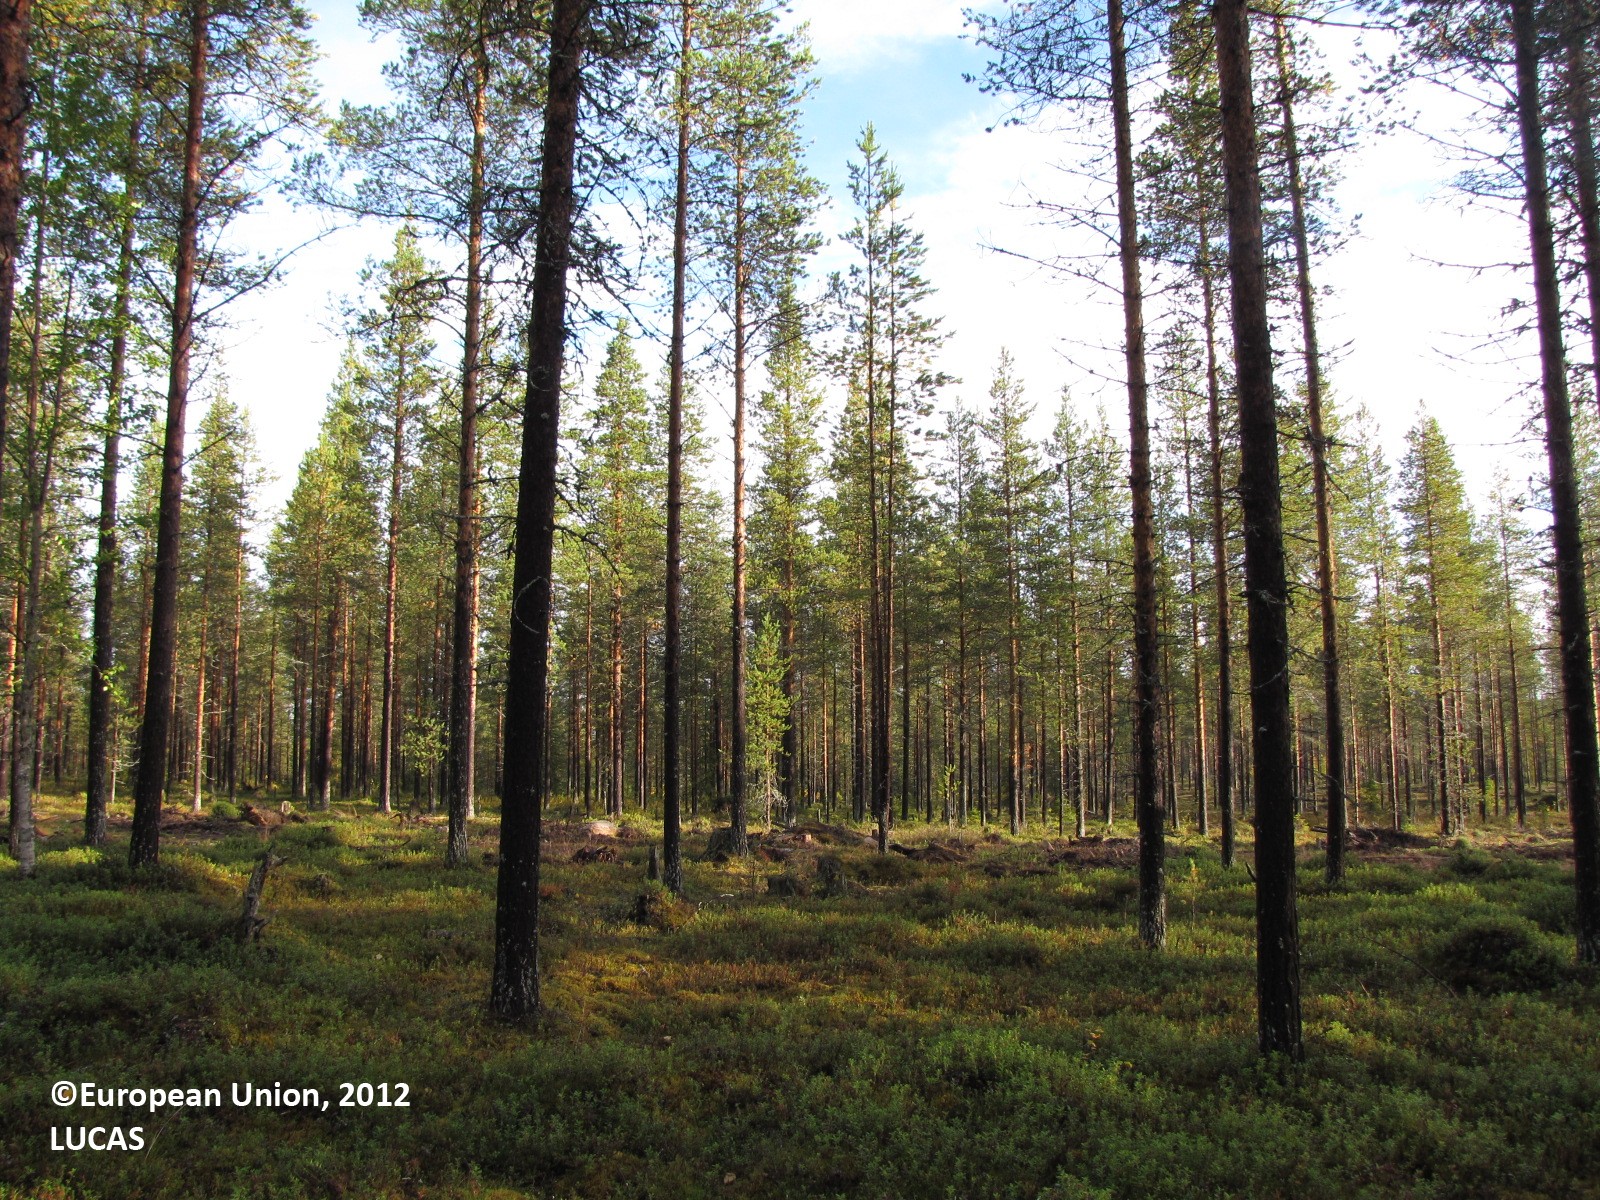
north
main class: Woodland
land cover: Pine dominated coniferous woodland
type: boreal forest
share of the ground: 50 - 75 %
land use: Forestry
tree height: > 5 m
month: September
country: FI
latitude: 67.2491
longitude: 25.4142
